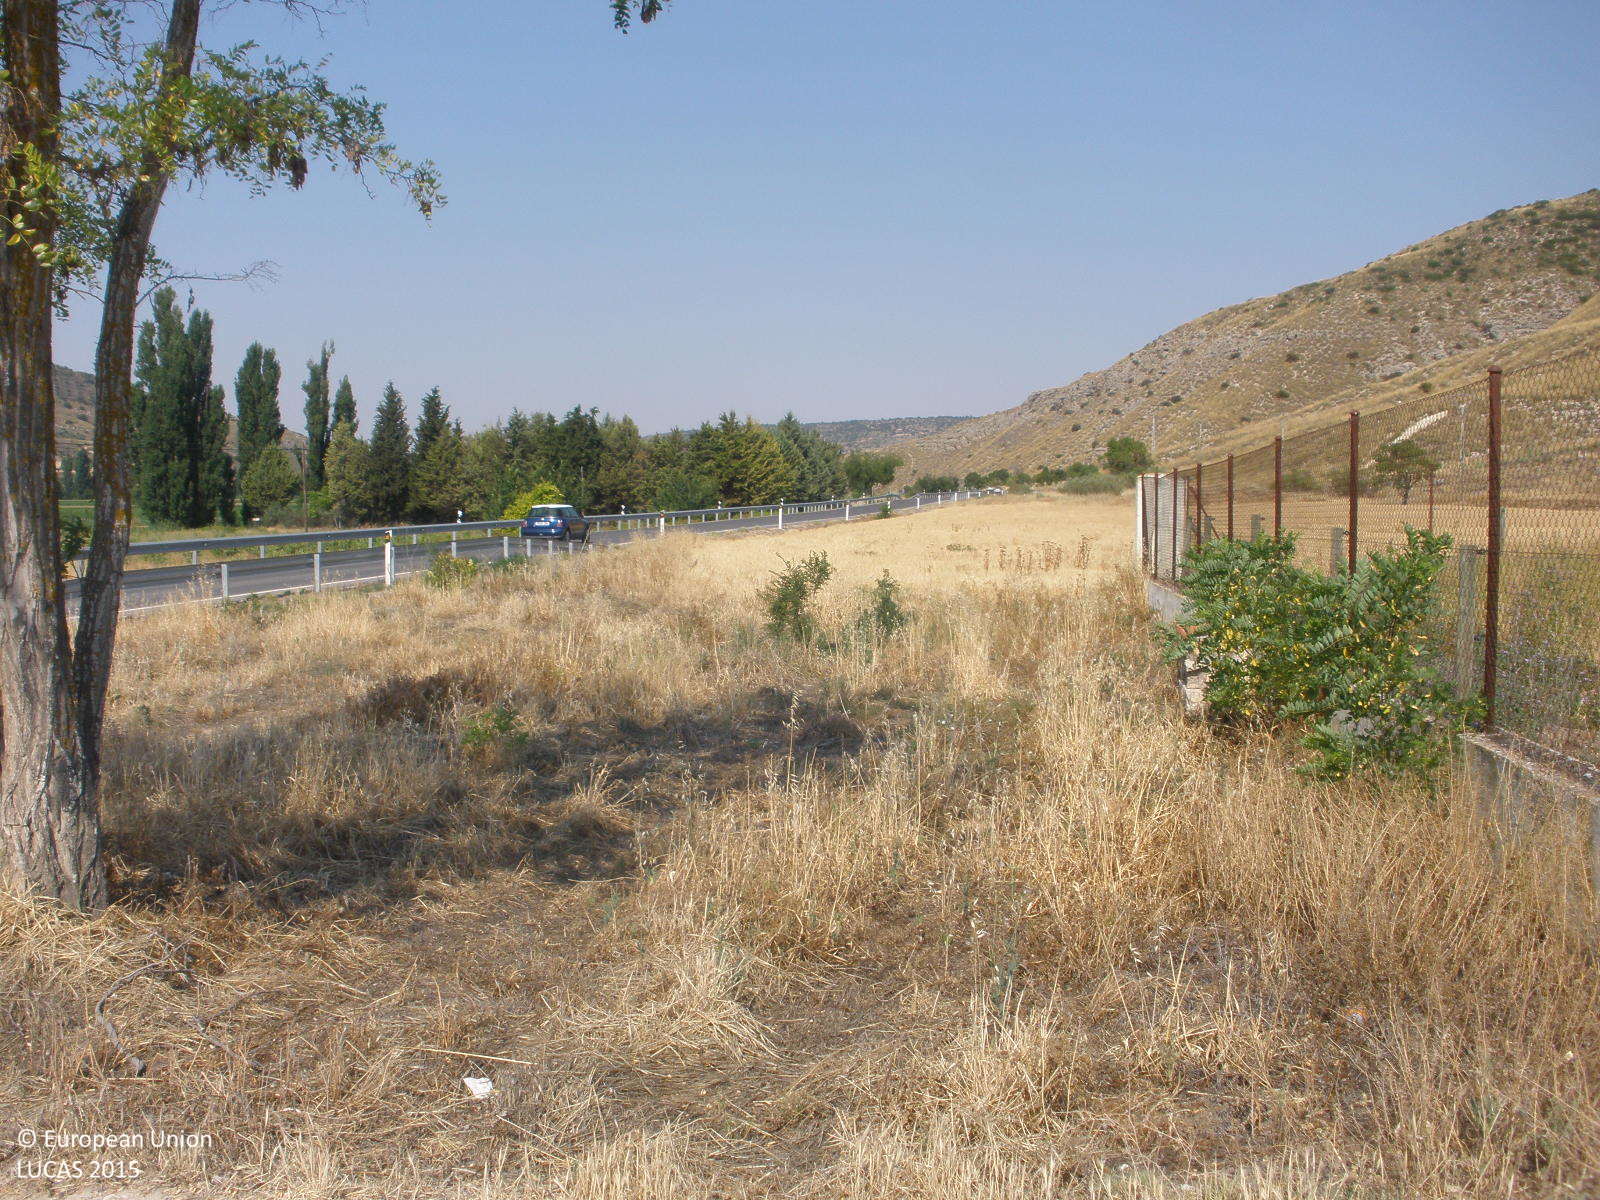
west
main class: Shrubland
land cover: Shrubland with sparse tree cover
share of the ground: 50 - 75 %
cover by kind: herbaceous plants 50 %, shrubs 45 %, broadleaved forest trees 5 %
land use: Semi-natural and natural areas not in use
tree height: < 5 m
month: June
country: ES
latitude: 40.2571
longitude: -3.2808
